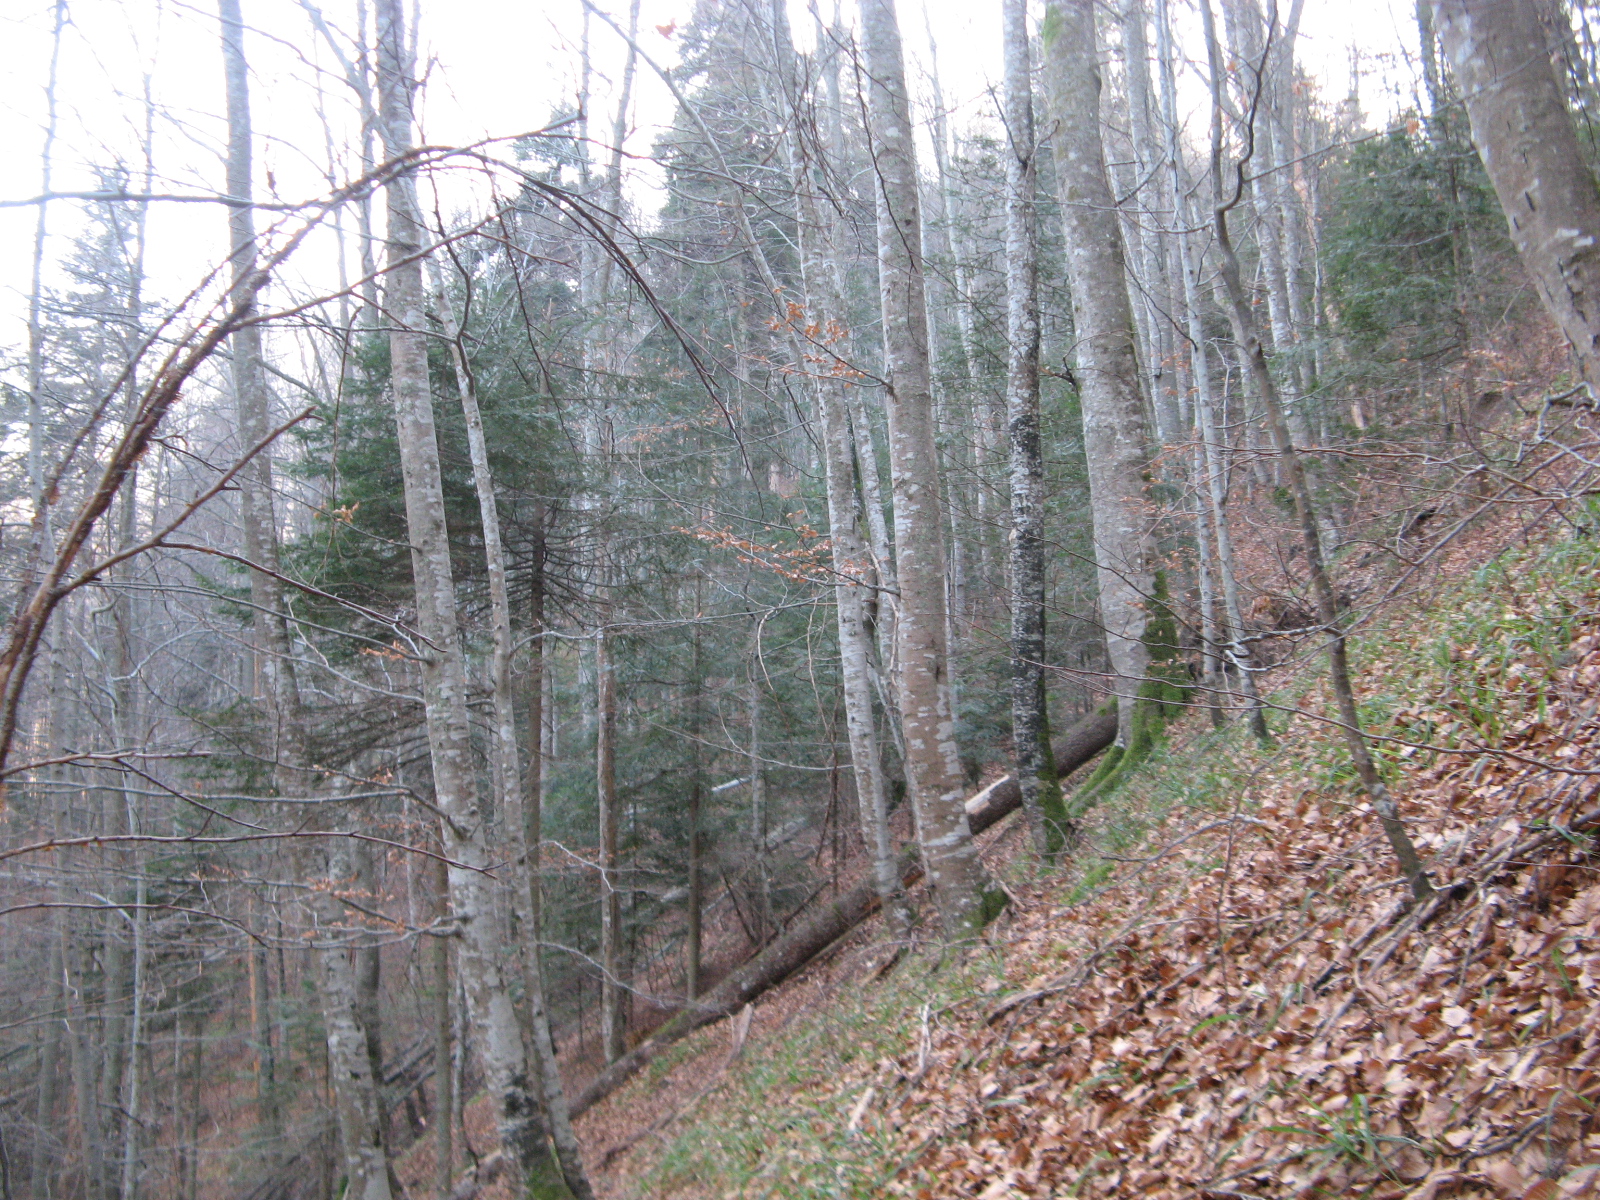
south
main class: Woodland
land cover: Other mixed woodland
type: hemiboreal forest and nemoral coniferous forest and mixed broadleaved-coniferous forest
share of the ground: > 75 %
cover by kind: broadleaved forest trees 45 %, coniferous forest trees 40 %, unconsolidated bare surface 10 %, herbaceous plants 5 %
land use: Forestry
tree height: > 5 m
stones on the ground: < 10 %
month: December
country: BG
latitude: 41.9526
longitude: 24.1170
